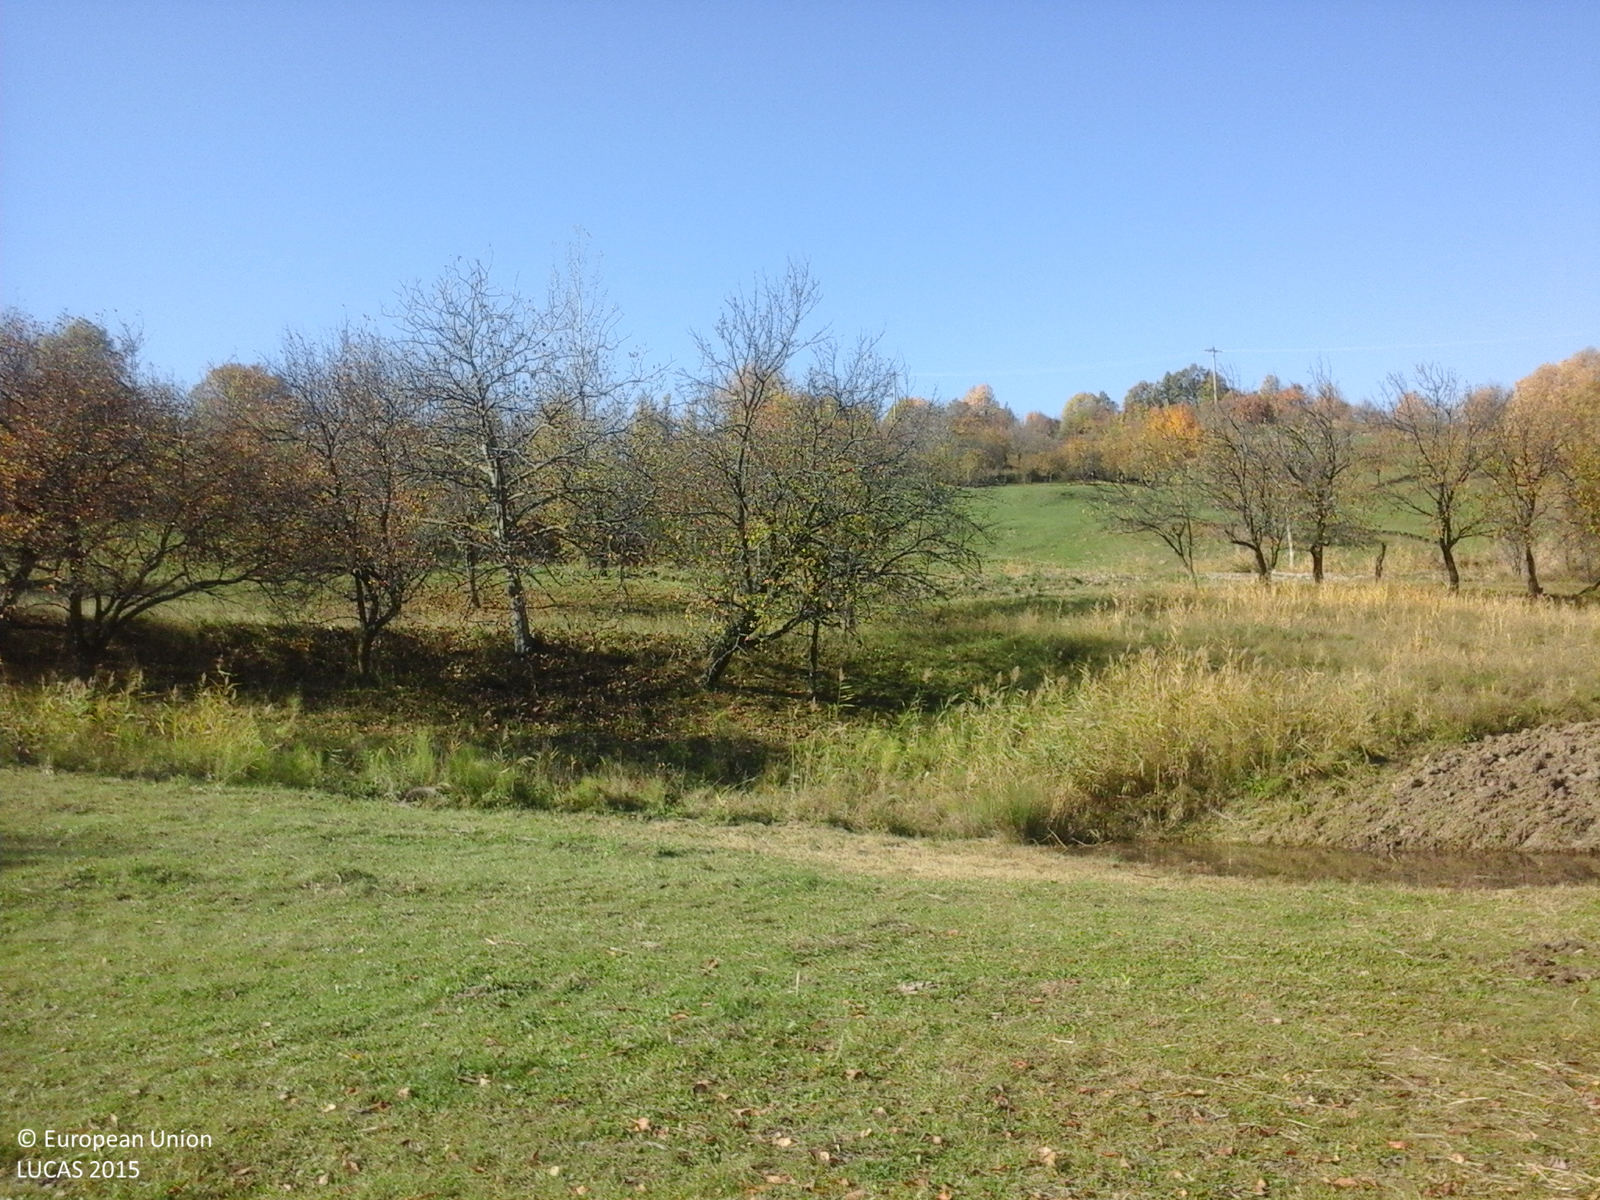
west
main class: Cropland
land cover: Other fruit trees and berries
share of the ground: 25 - 50 %
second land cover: Grassland without tree/shrub cover
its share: > 75 %
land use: Agriculture (excluding fallow land and kitchen gardens)
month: October
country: RO
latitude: 45.4833
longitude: 26.8302
